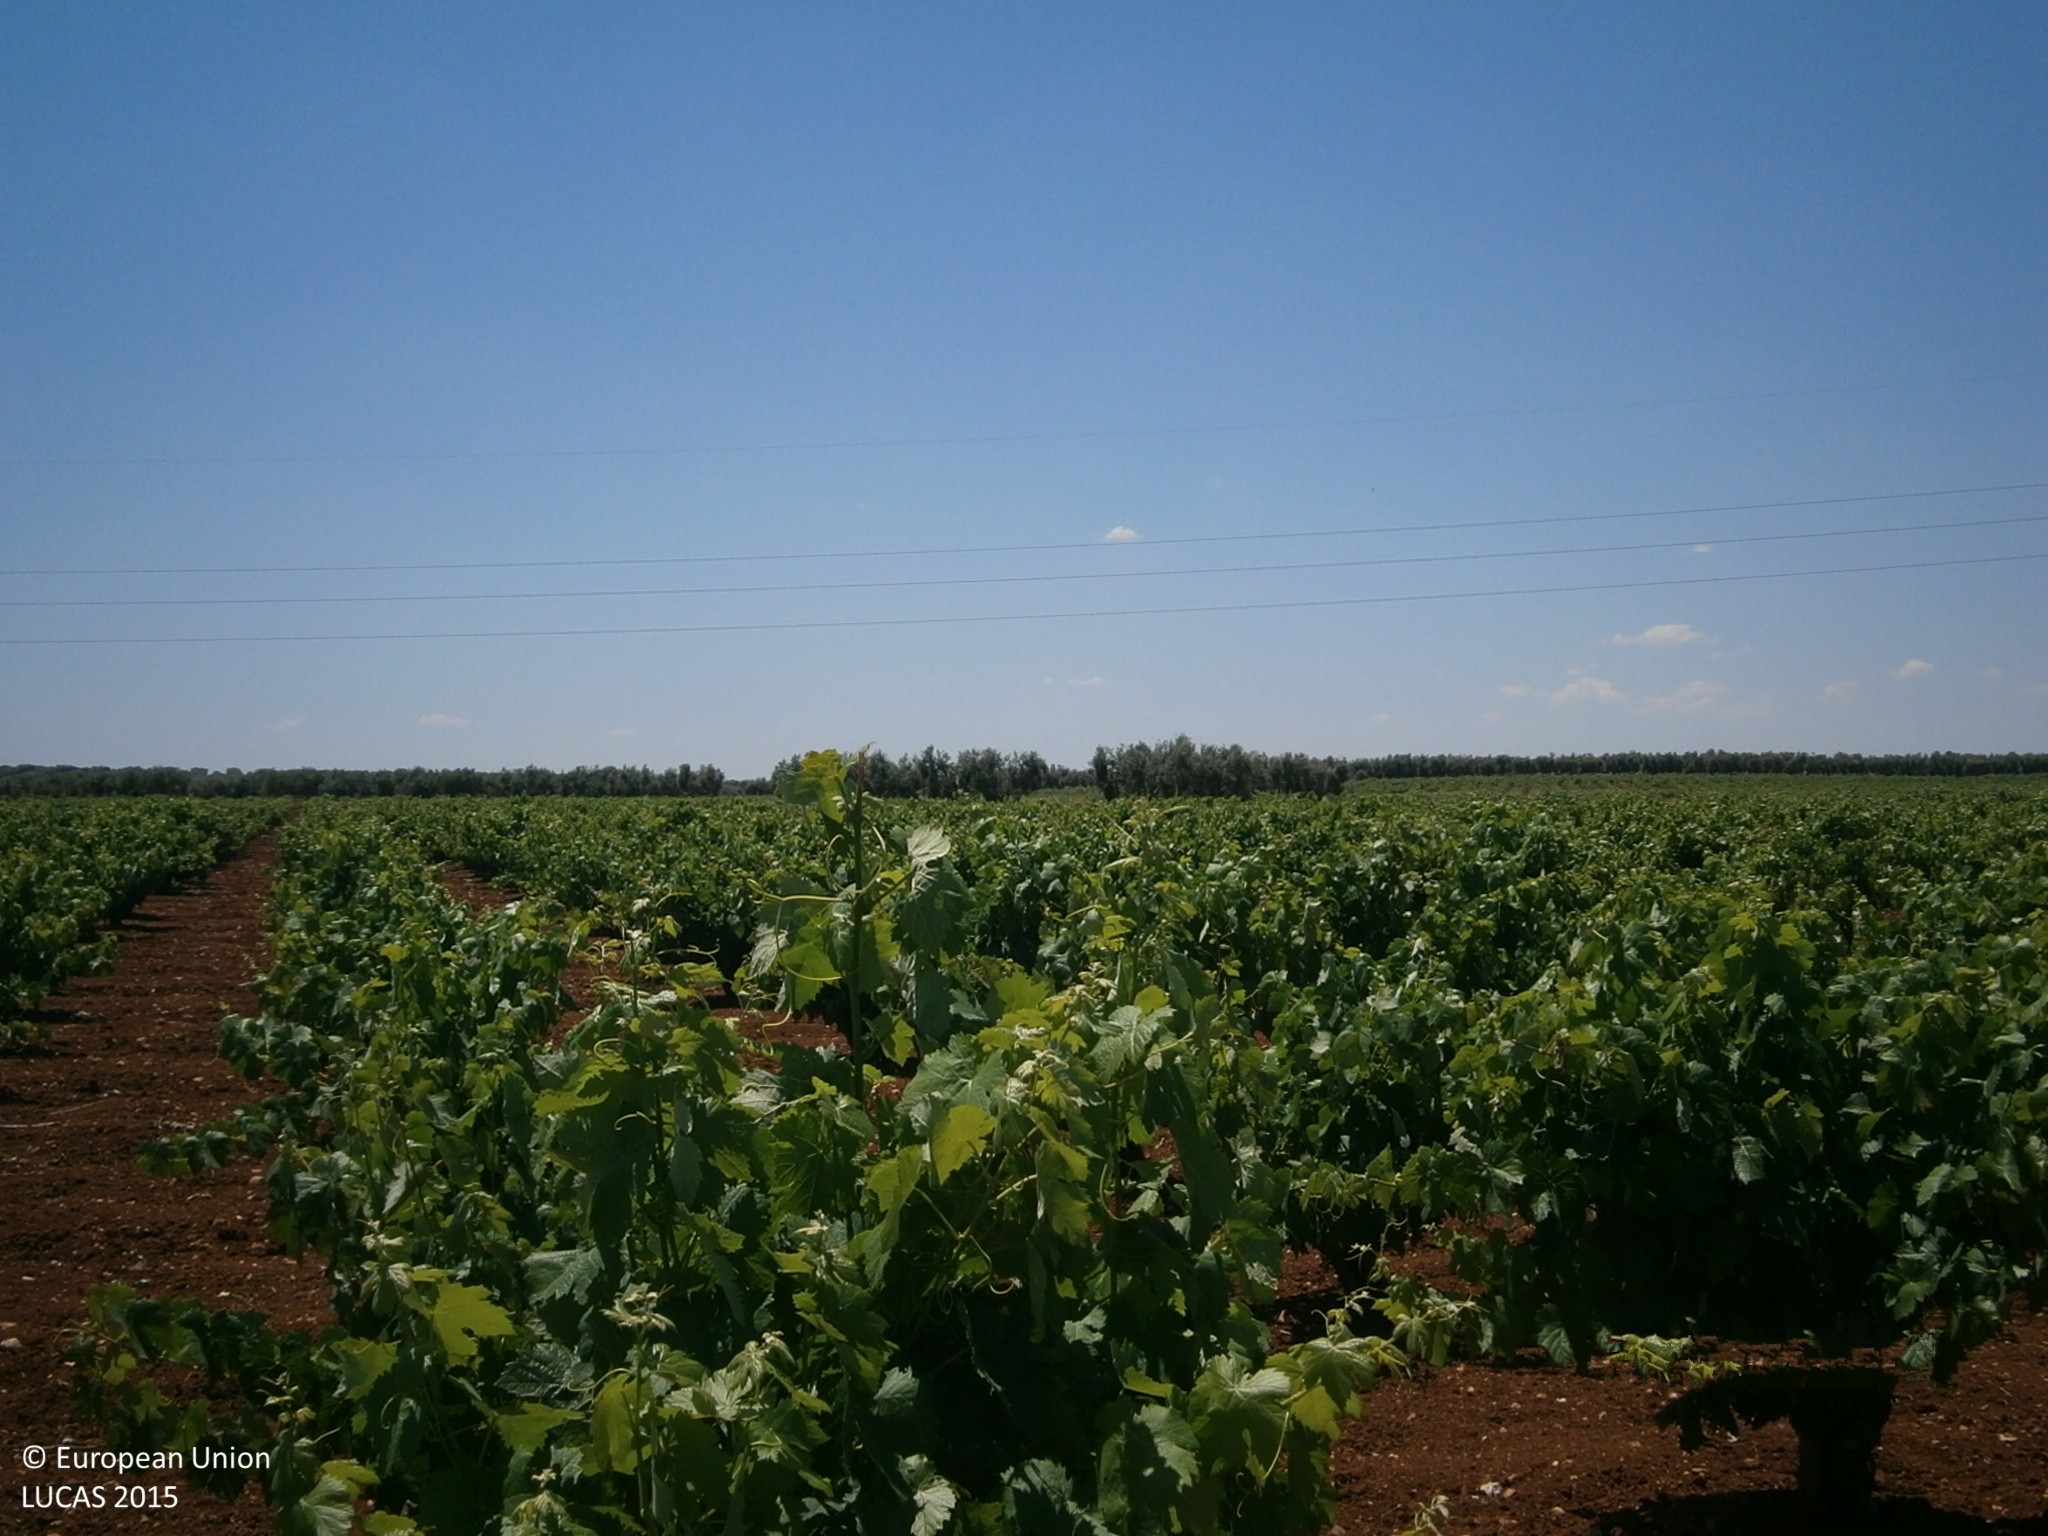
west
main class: Cropland
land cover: Vineyards
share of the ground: 25 - 50 %
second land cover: Other bare soil
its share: > 75 %
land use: Agriculture (excluding fallow land and kitchen gardens)
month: June
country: ES
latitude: 38.6407
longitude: -6.3791
